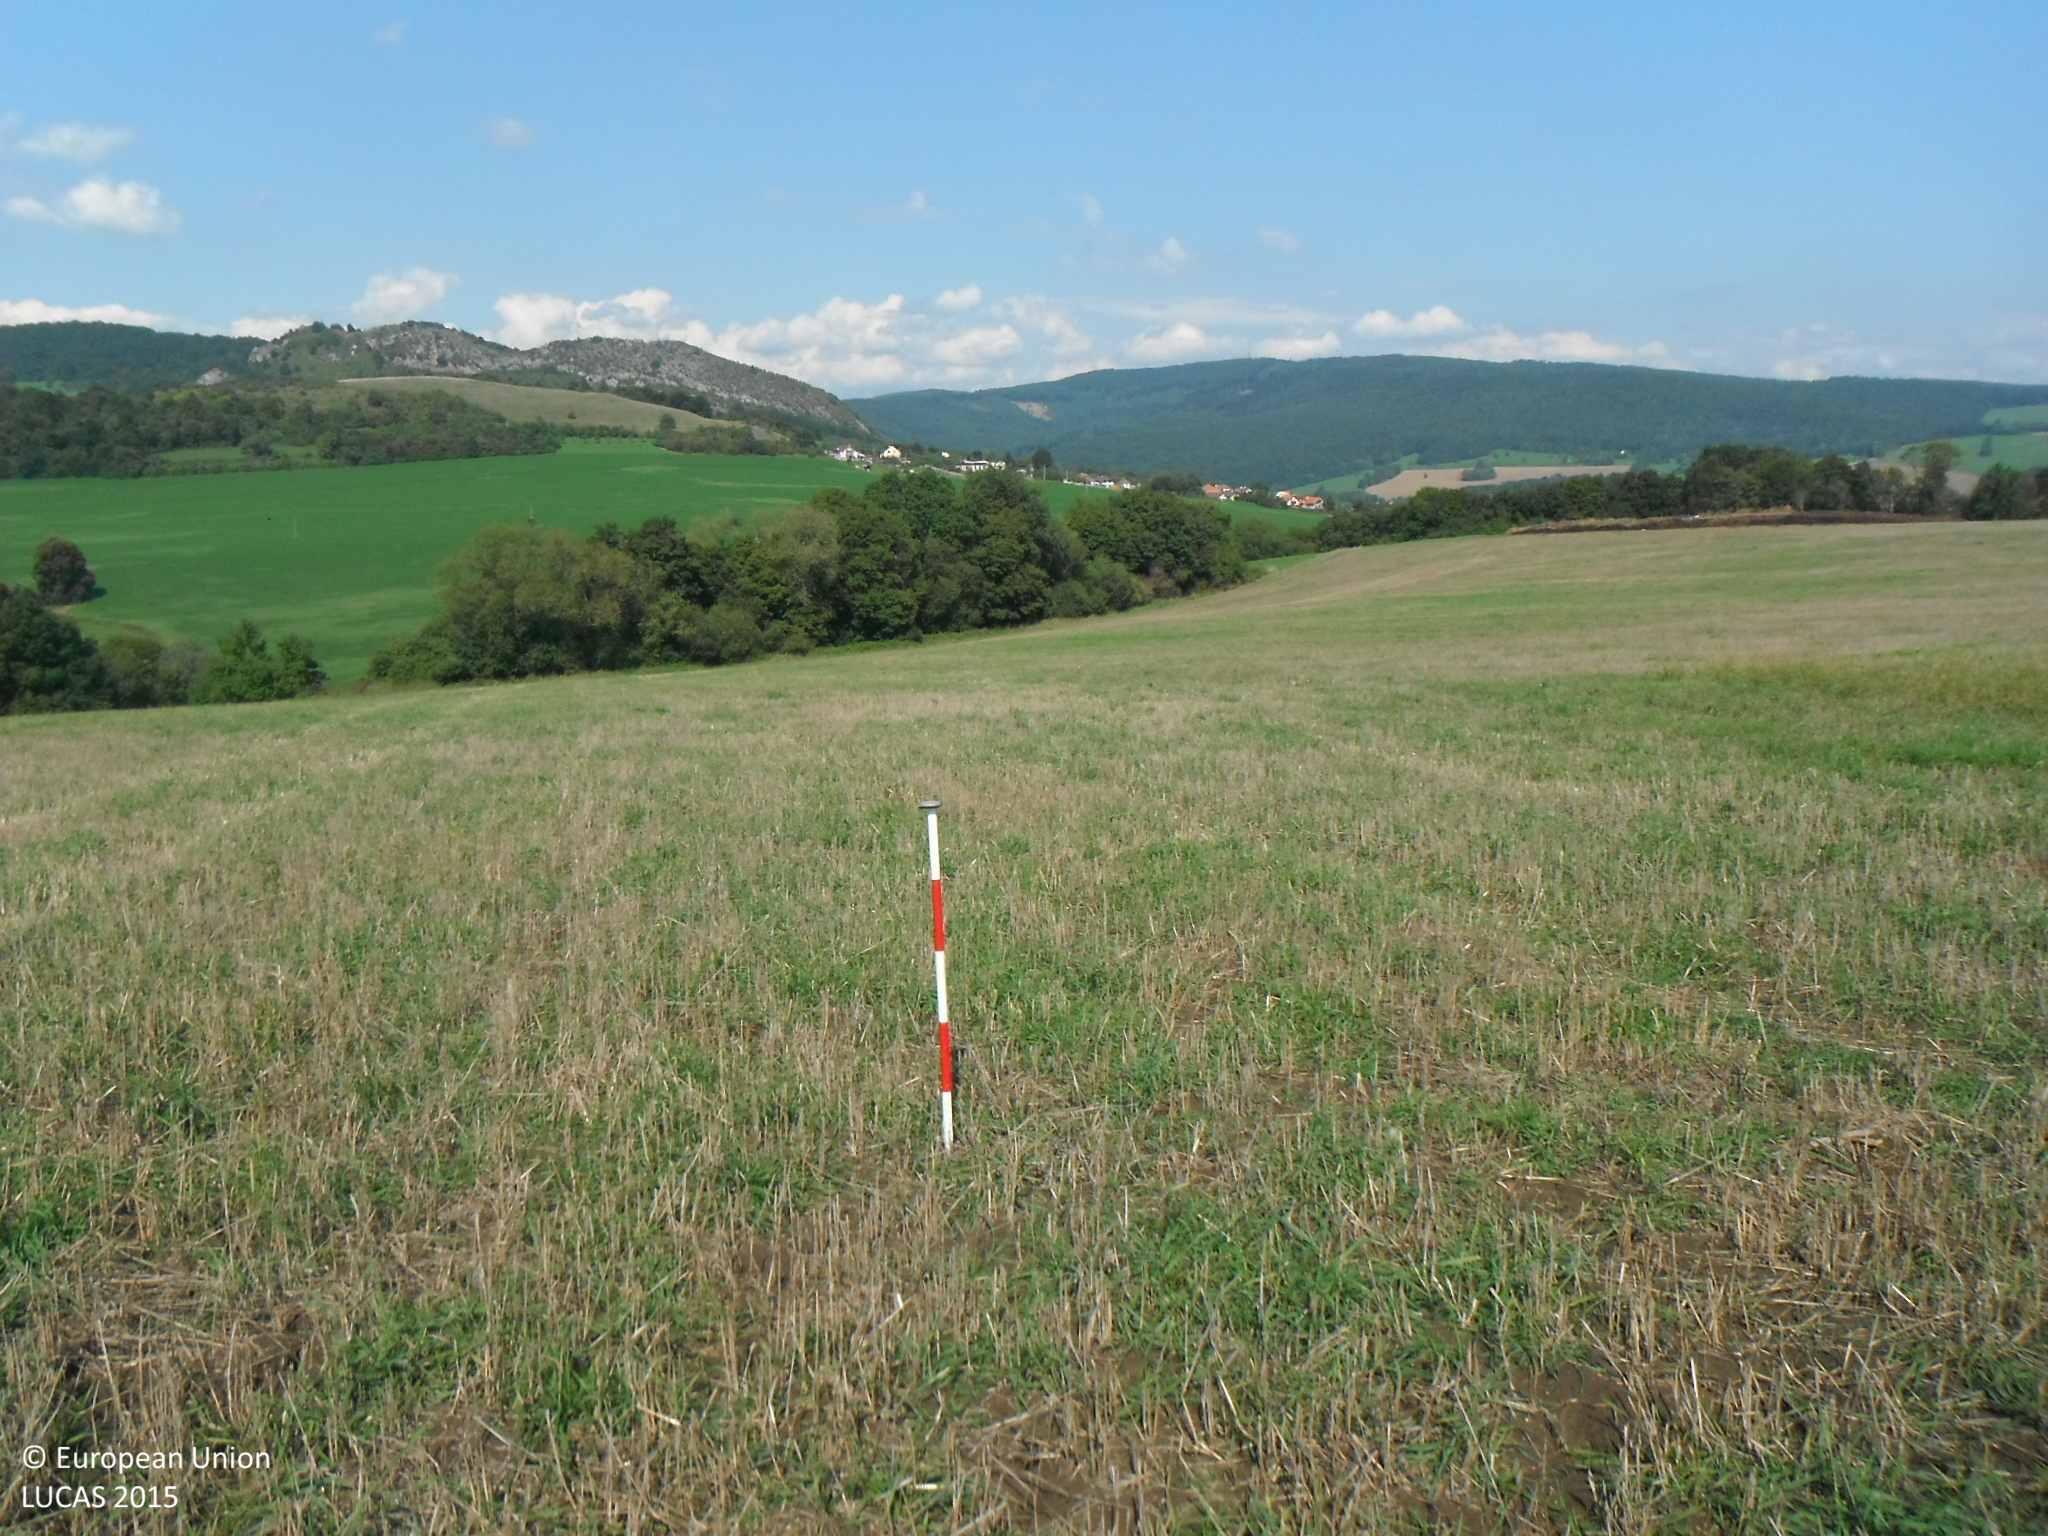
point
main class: Cropland
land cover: Common wheat
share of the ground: < 10 %
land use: Agriculture (excluding fallow land and kitchen gardens)
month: September
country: SK
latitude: 48.9428
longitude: 18.0289
